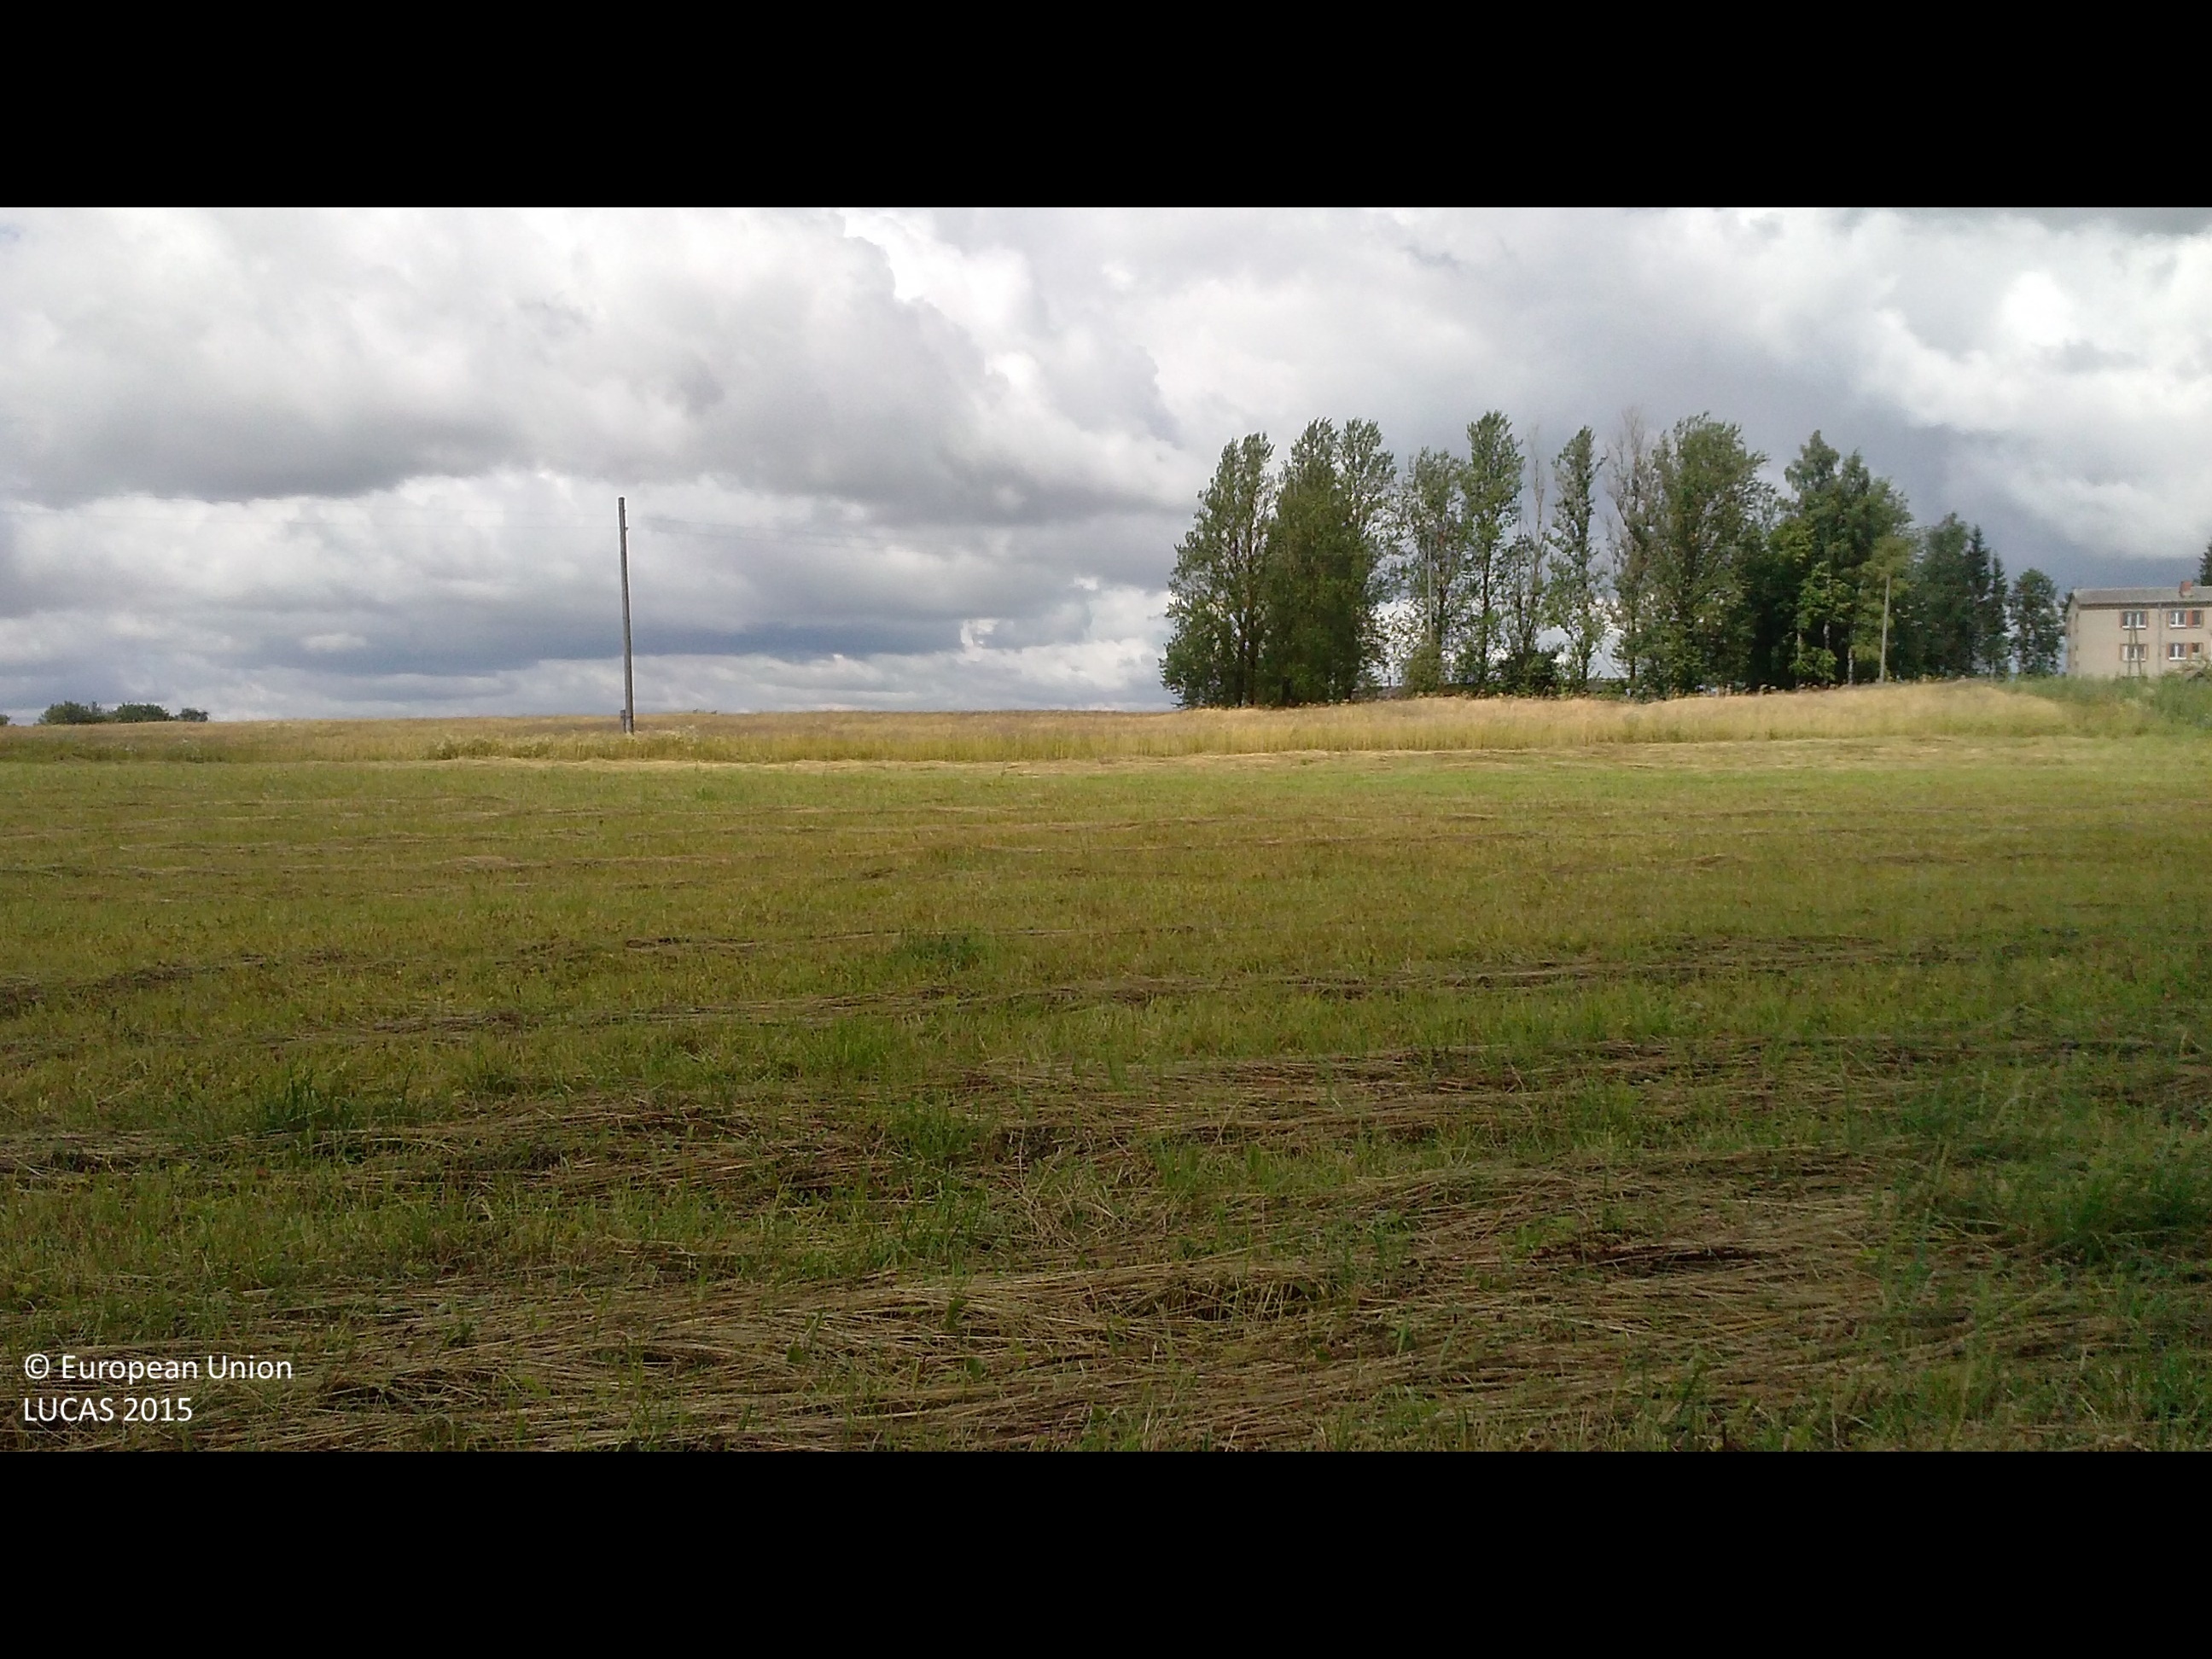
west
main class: Grassland
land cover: Grassland without tree/shrub cover
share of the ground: > 75 %
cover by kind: herbaceous plants 95 %, unconsolidated bare surface 5 %
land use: Agriculture (excluding fallow land and kitchen gardens)
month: July
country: LV
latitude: 56.4781
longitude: 26.9999
